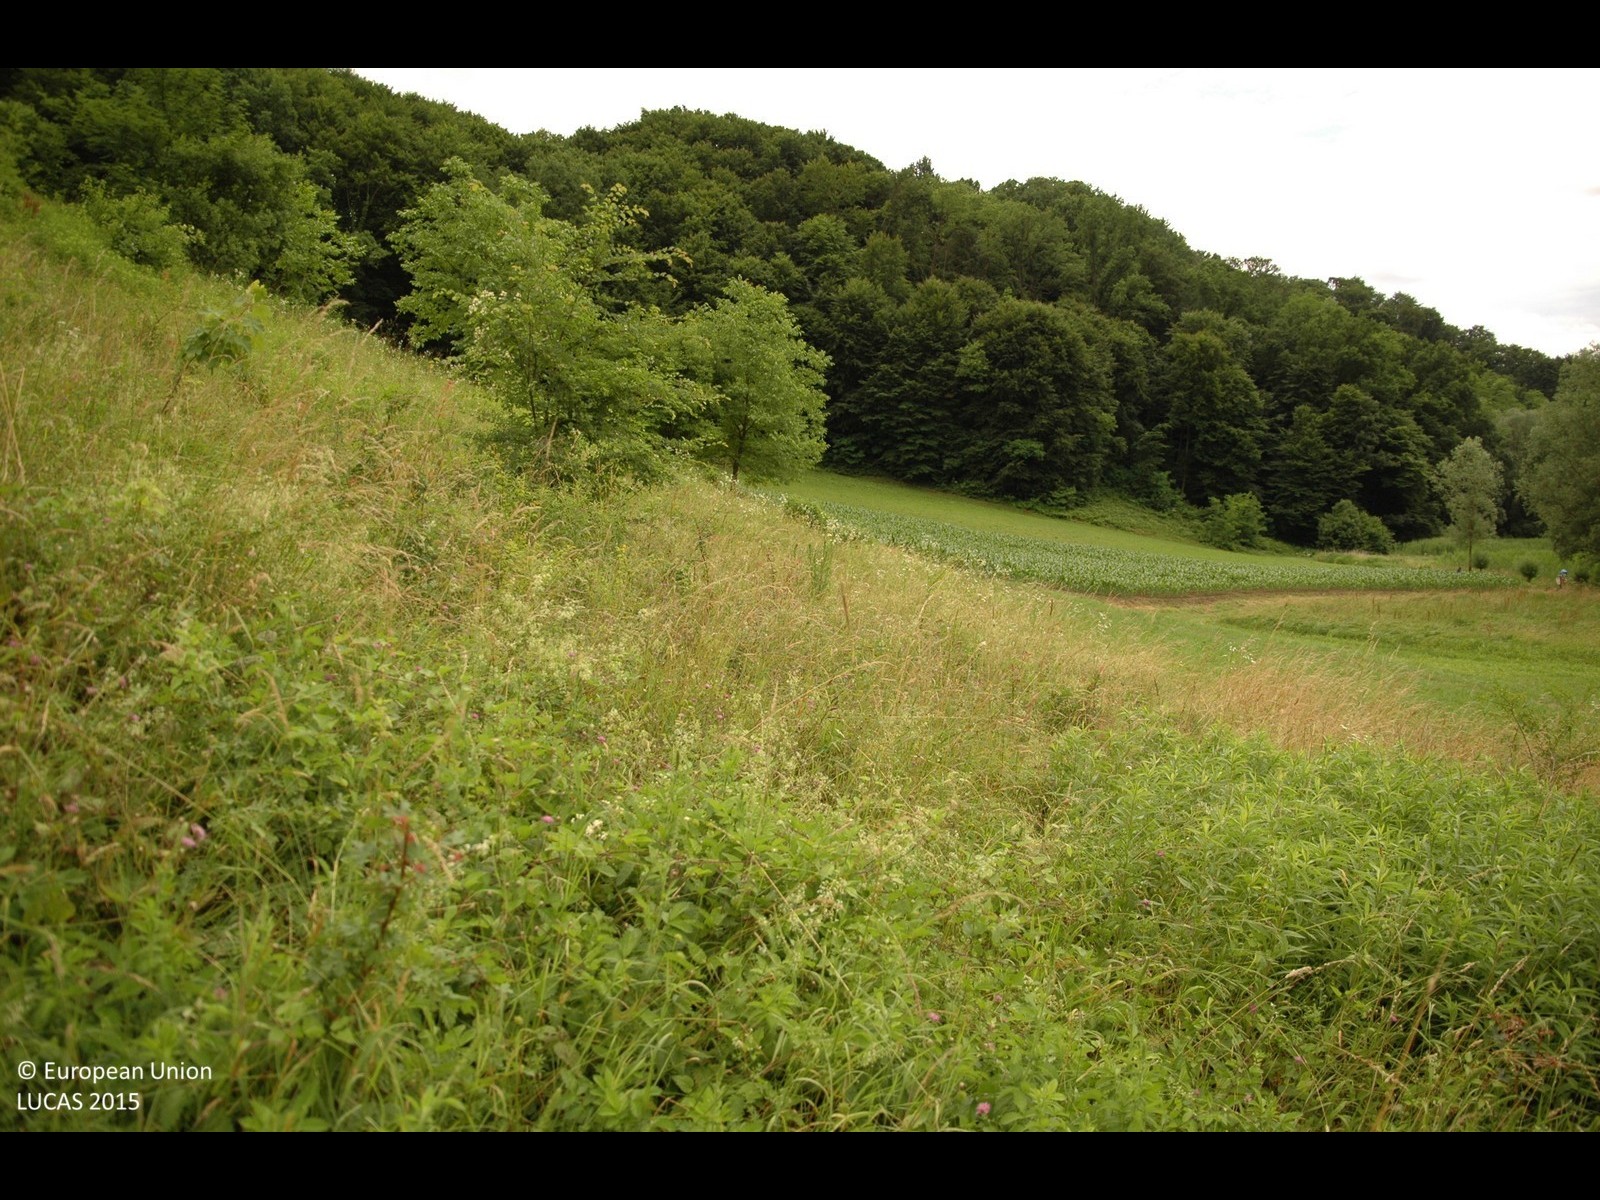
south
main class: Grassland
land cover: Spontaneously vegetated surfaces
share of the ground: > 75 %
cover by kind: herbaceous plants 95 %, shrubs 5 %
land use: Abandoned areas
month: June
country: HR
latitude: 46.0989
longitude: 15.8841
